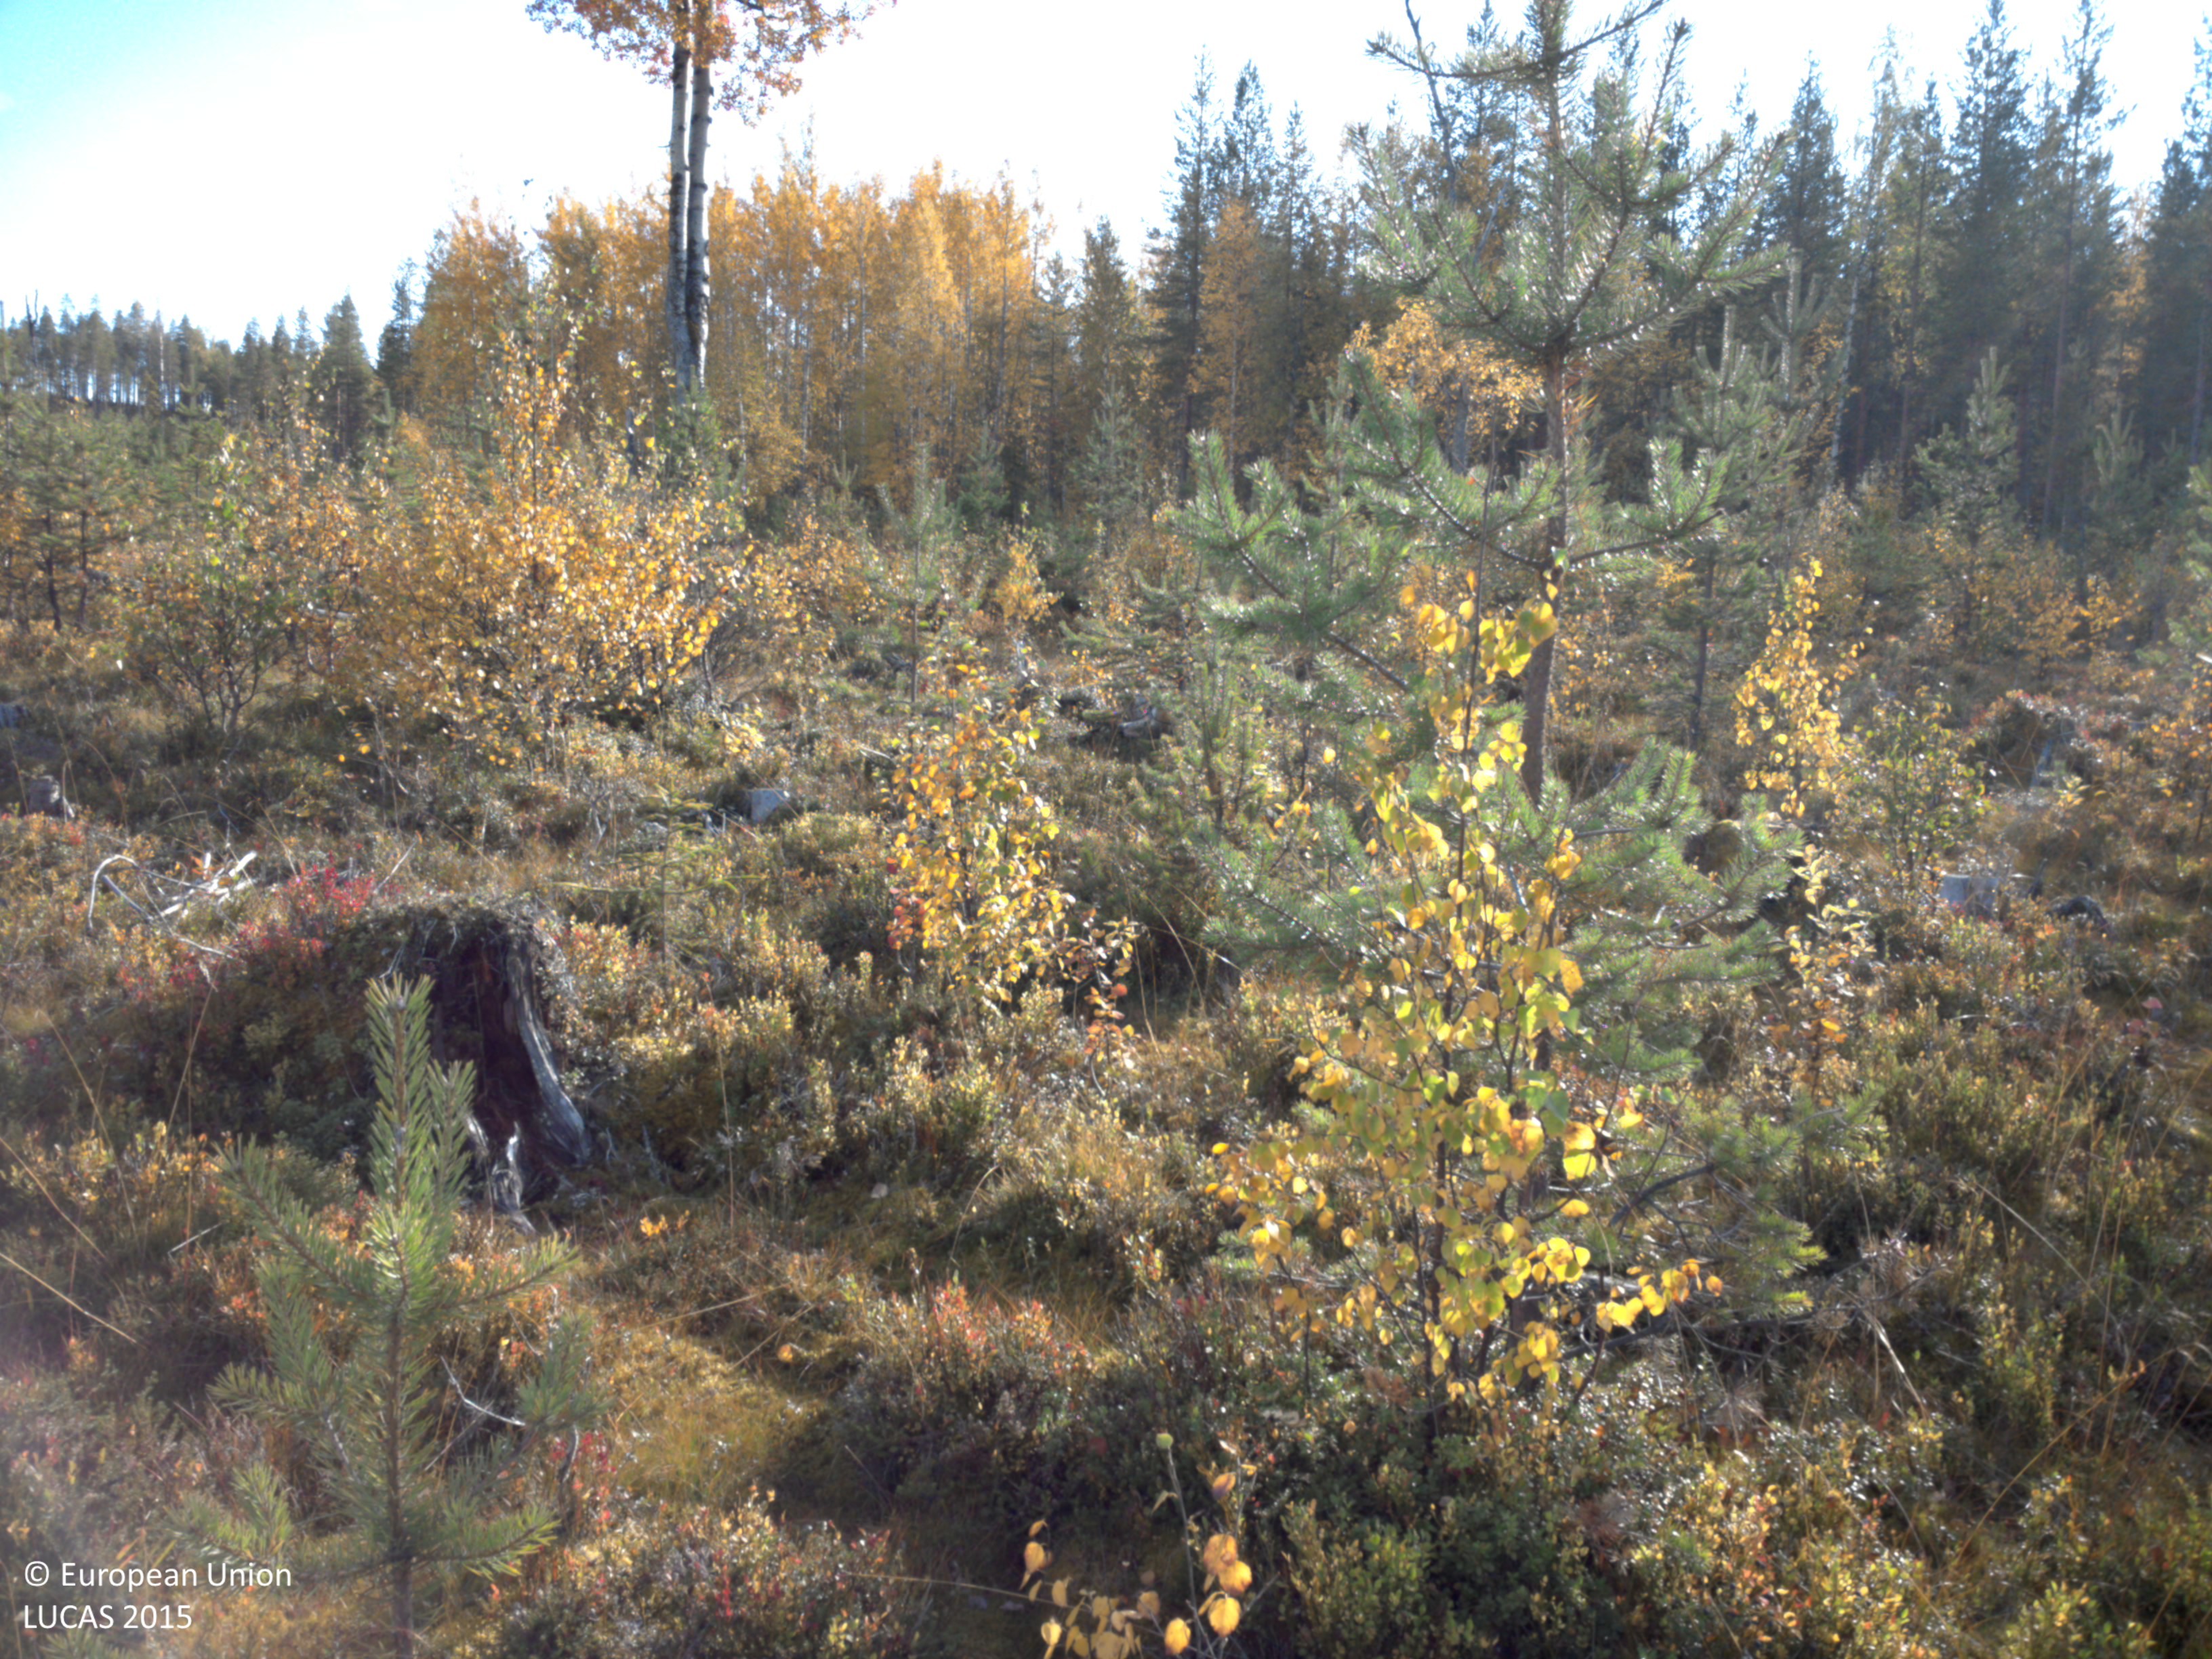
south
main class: Woodland
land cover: Other mixed woodland
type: boreal forest
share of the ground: 50 - 75 %
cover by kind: coniferous forest trees 50 %, broadleaved forest trees 25 %, shrubs 15 %, herbaceous plants 5 %, lichens and mosses 5 %
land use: Forestry
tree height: < 5 m
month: September
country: SE
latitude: 64.7728
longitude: 19.1151
